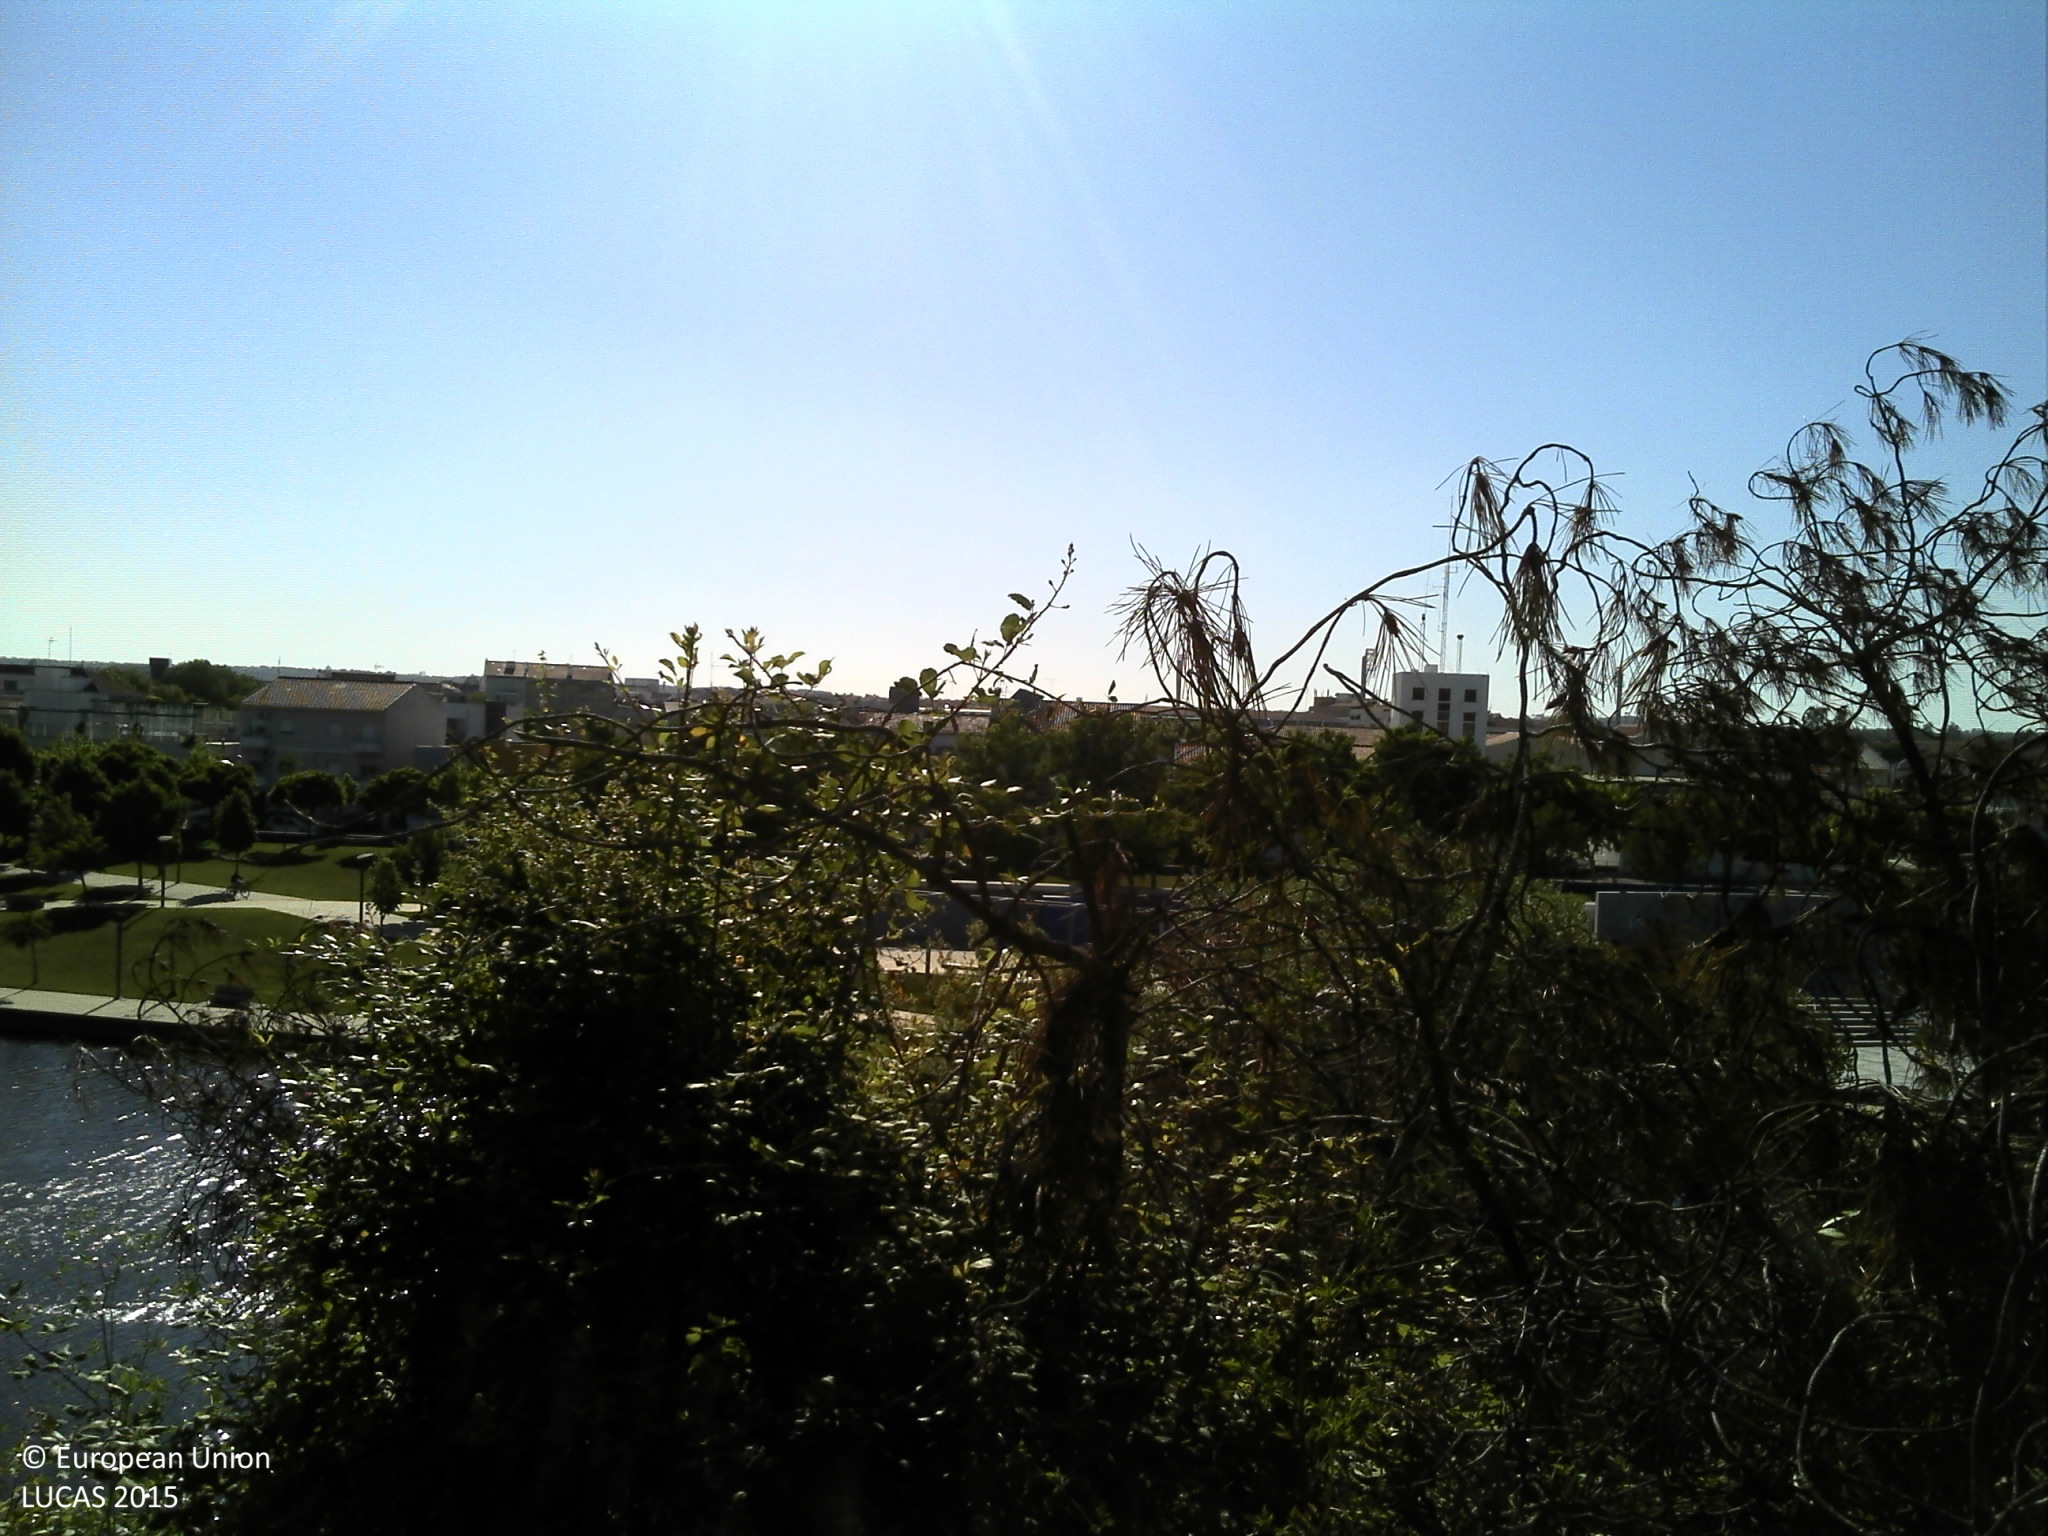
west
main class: Woodland
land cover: Pine dominated coniferous woodland
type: coniferous forest of the mediterranean region
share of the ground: 25 - 50 %
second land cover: Shrubland without tree cover
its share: 50 - 75 %
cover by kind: shrubs 50 %, coniferous forest trees 40 %, unconsolidated bare surface 10 %
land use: Abandoned areas
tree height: > 5 m
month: May
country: PT
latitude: 39.2516
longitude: -8.0043
